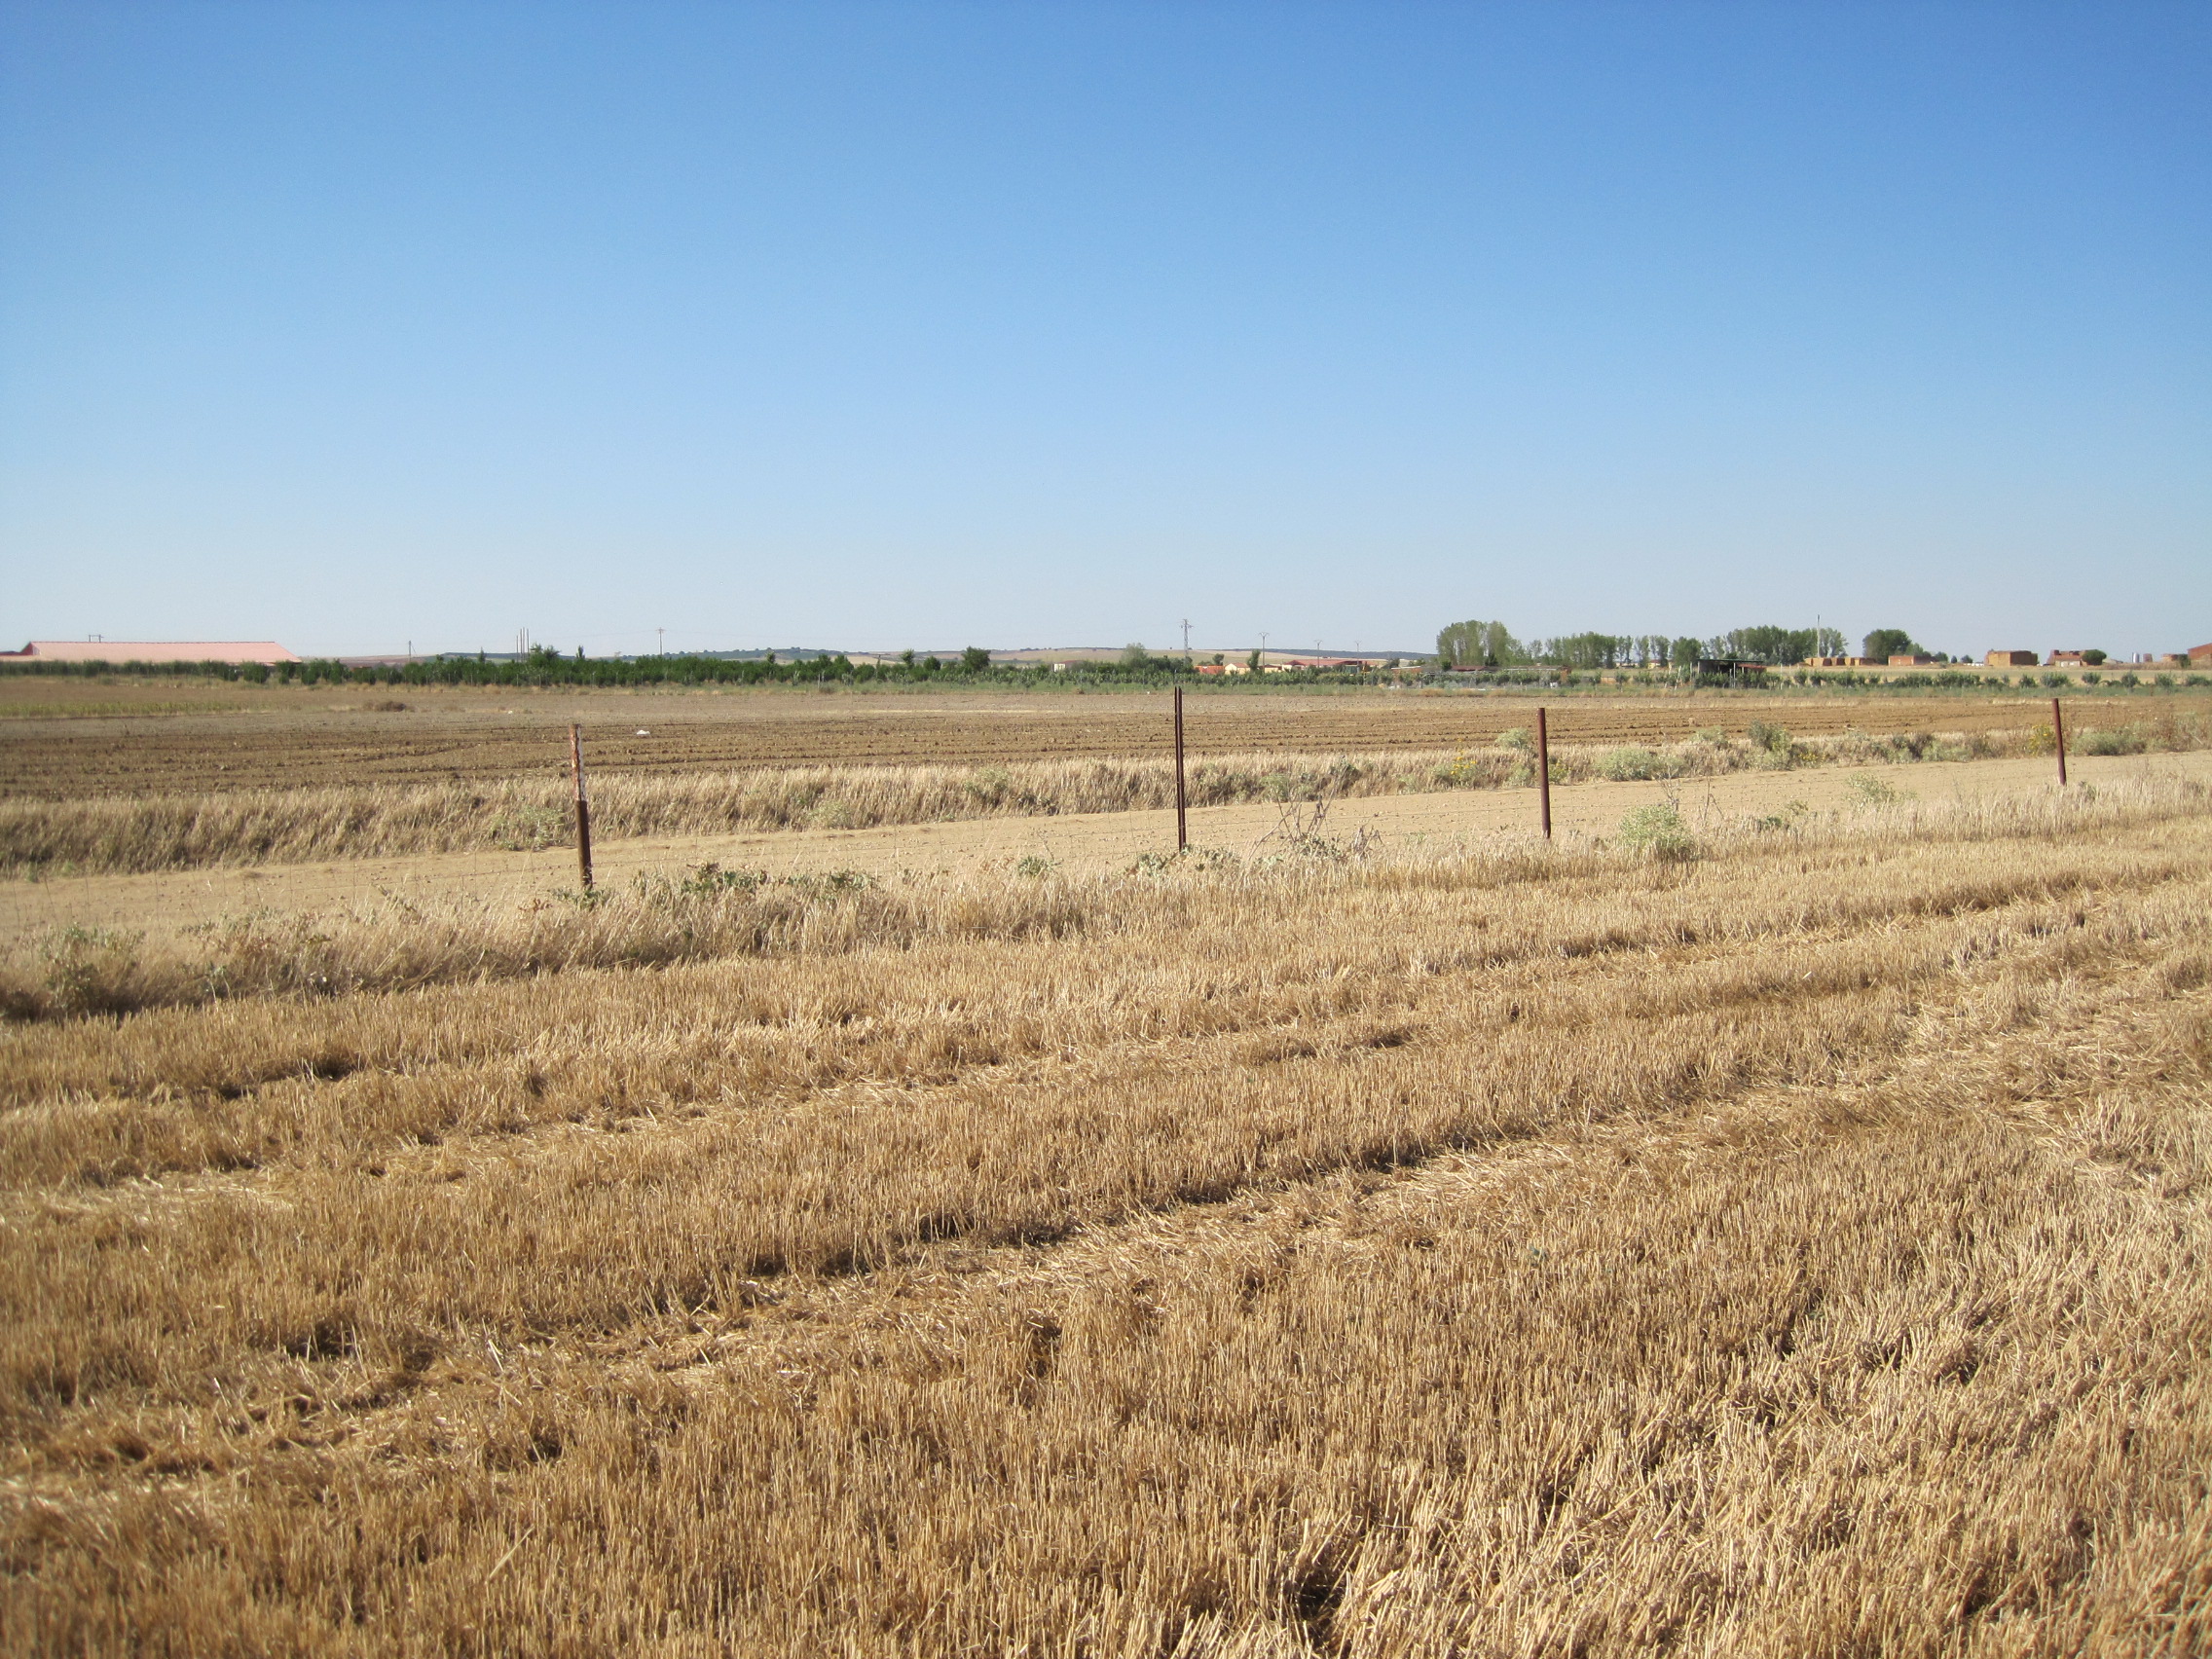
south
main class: Cropland
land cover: Barley
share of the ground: < 10 %
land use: Agriculture (excluding fallow land and kitchen gardens)
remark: Harvested field
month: July
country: ES
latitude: 41.8721
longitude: -5.3983
